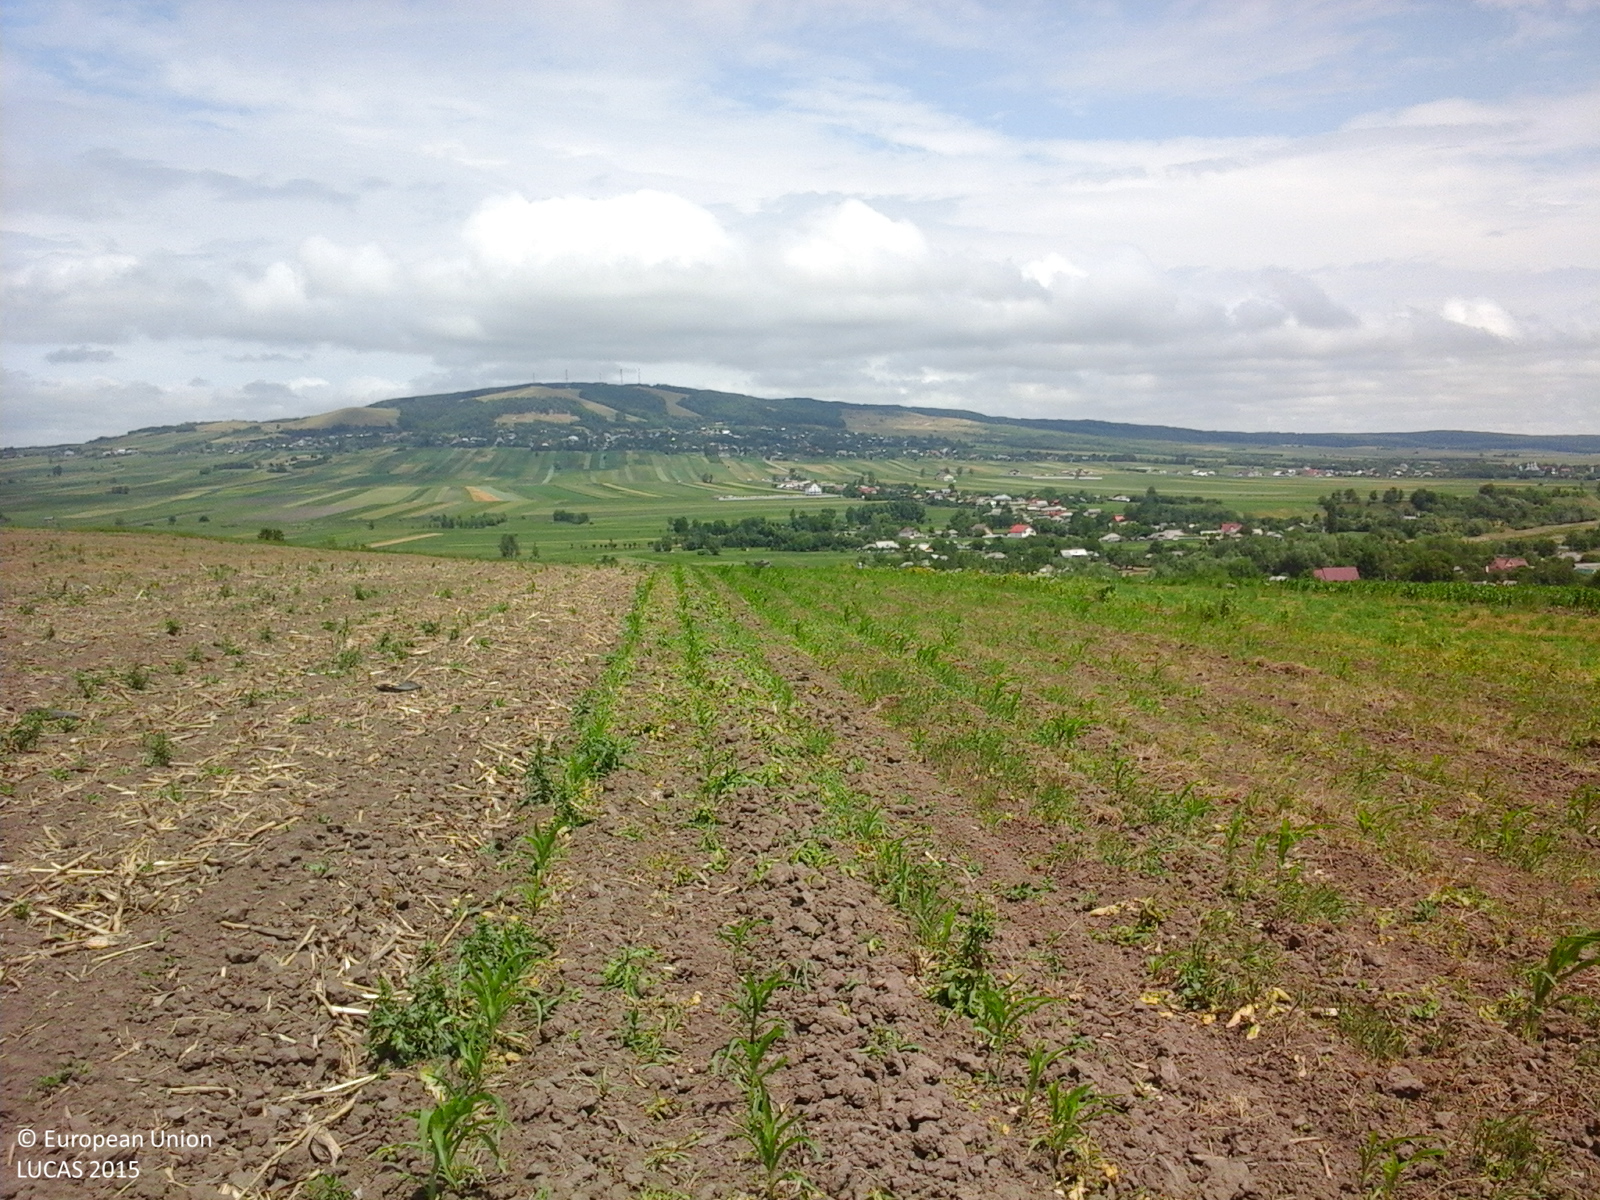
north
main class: Cropland
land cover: Maize
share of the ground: 25 - 50 %
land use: Agriculture (excluding fallow land and kitchen gardens)
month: May
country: RO
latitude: 47.1459
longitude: 26.4231
